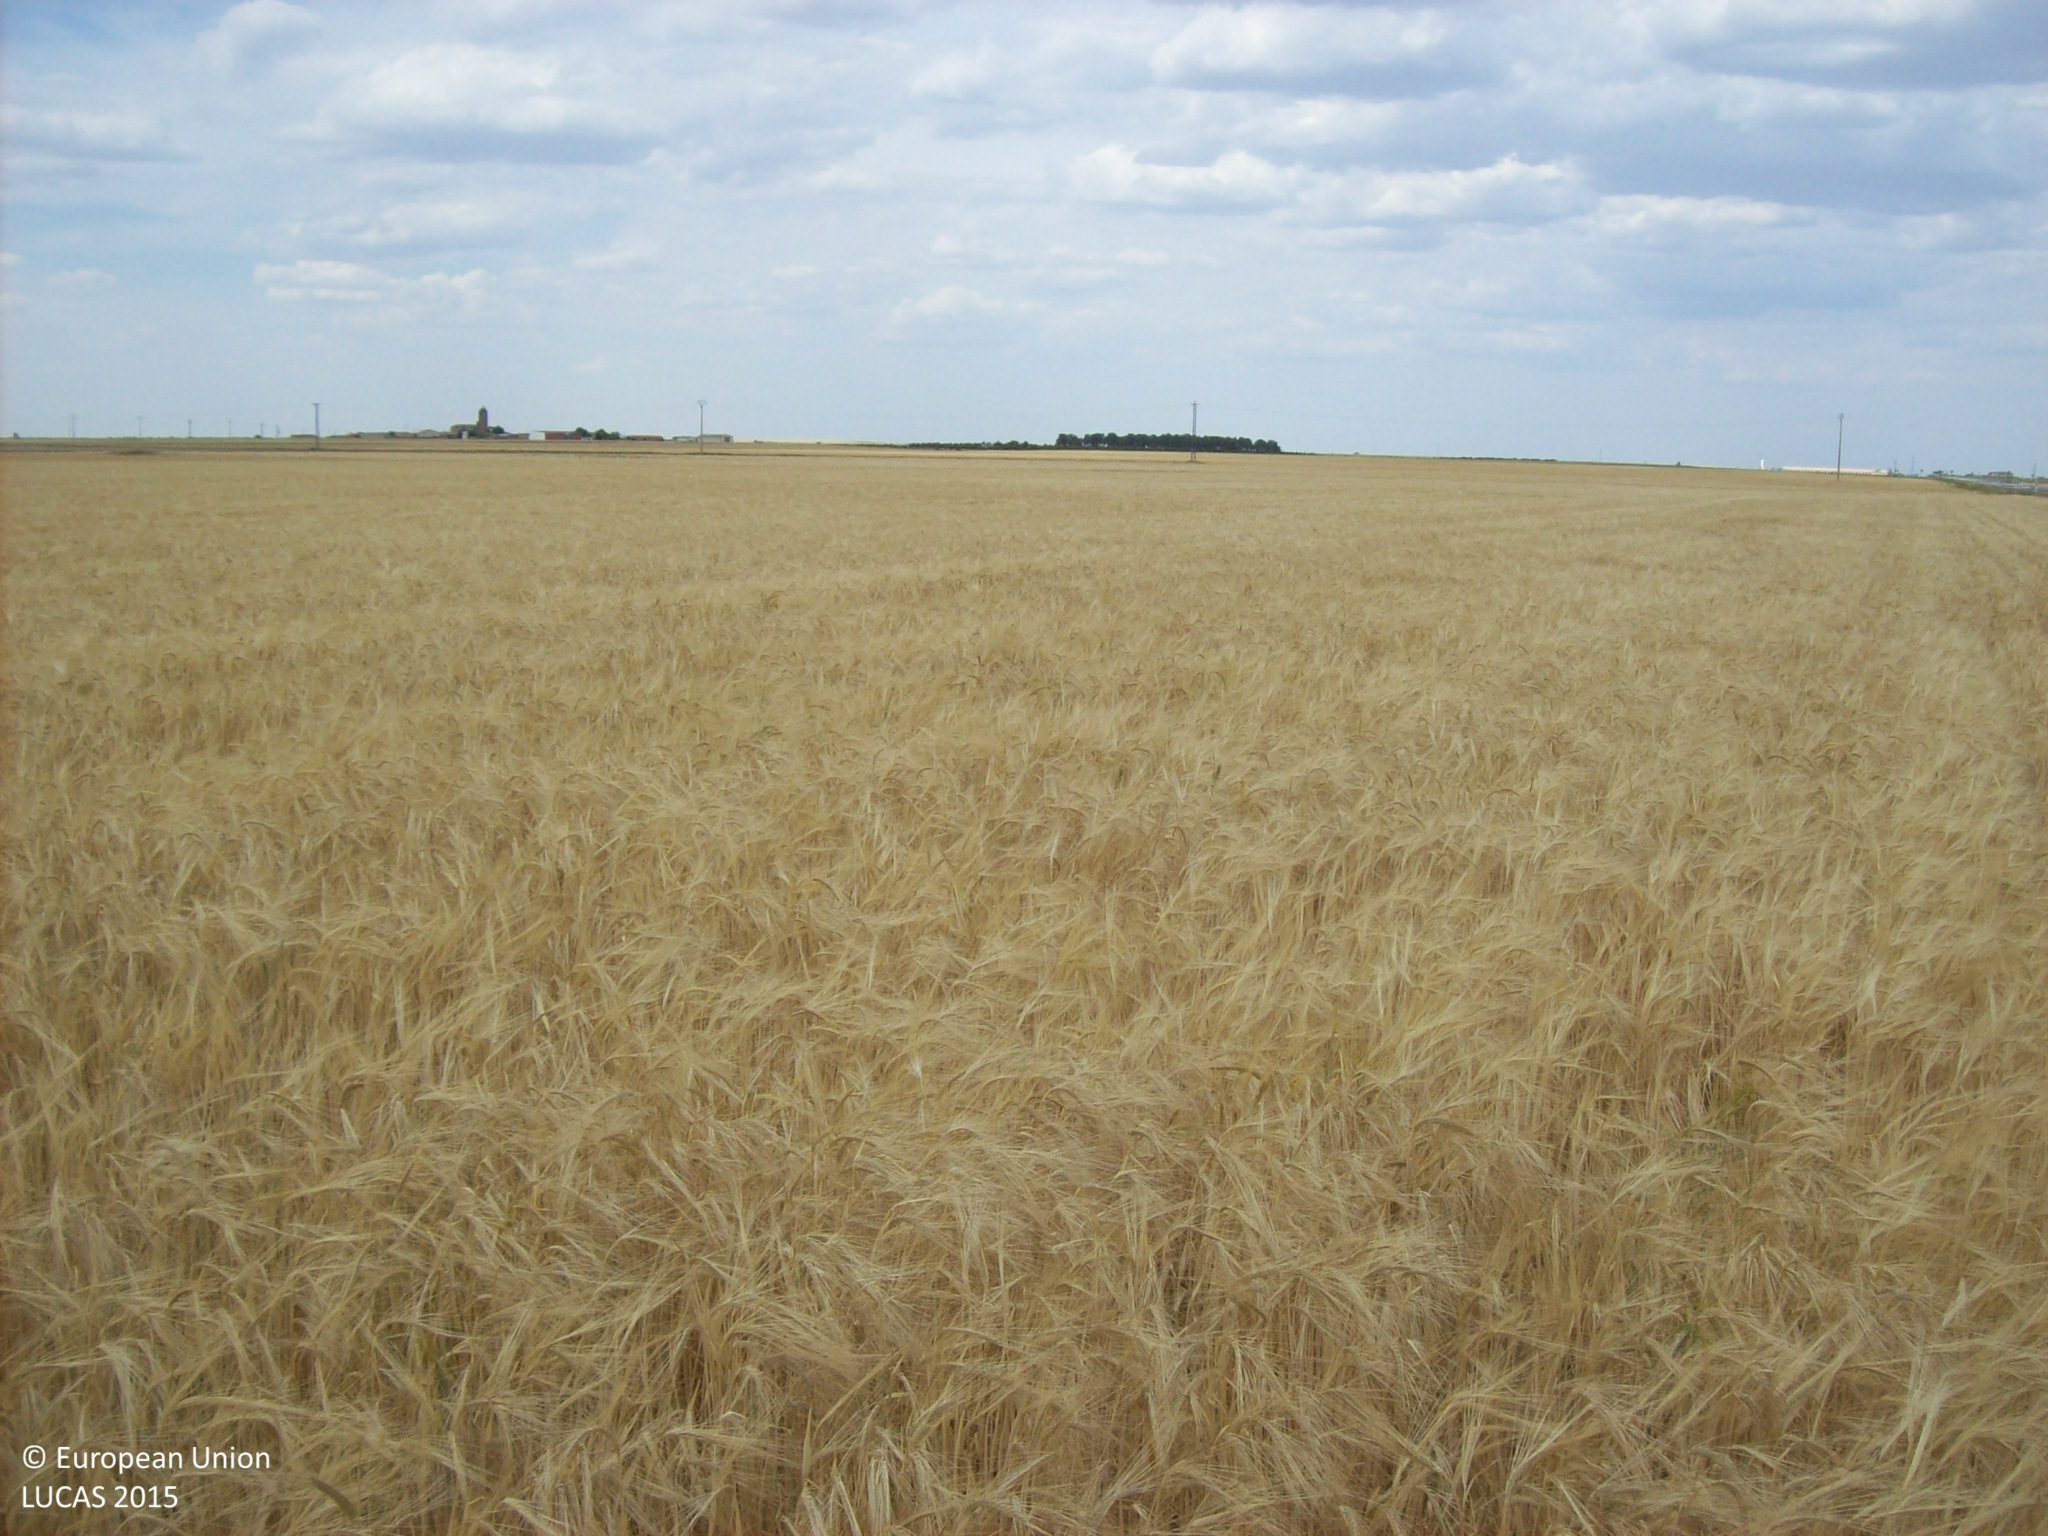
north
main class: Cropland
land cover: Barley
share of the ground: > 75 %
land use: Agriculture (excluding fallow land and kitchen gardens)
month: June
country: ES
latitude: 41.1097
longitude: -4.9877
